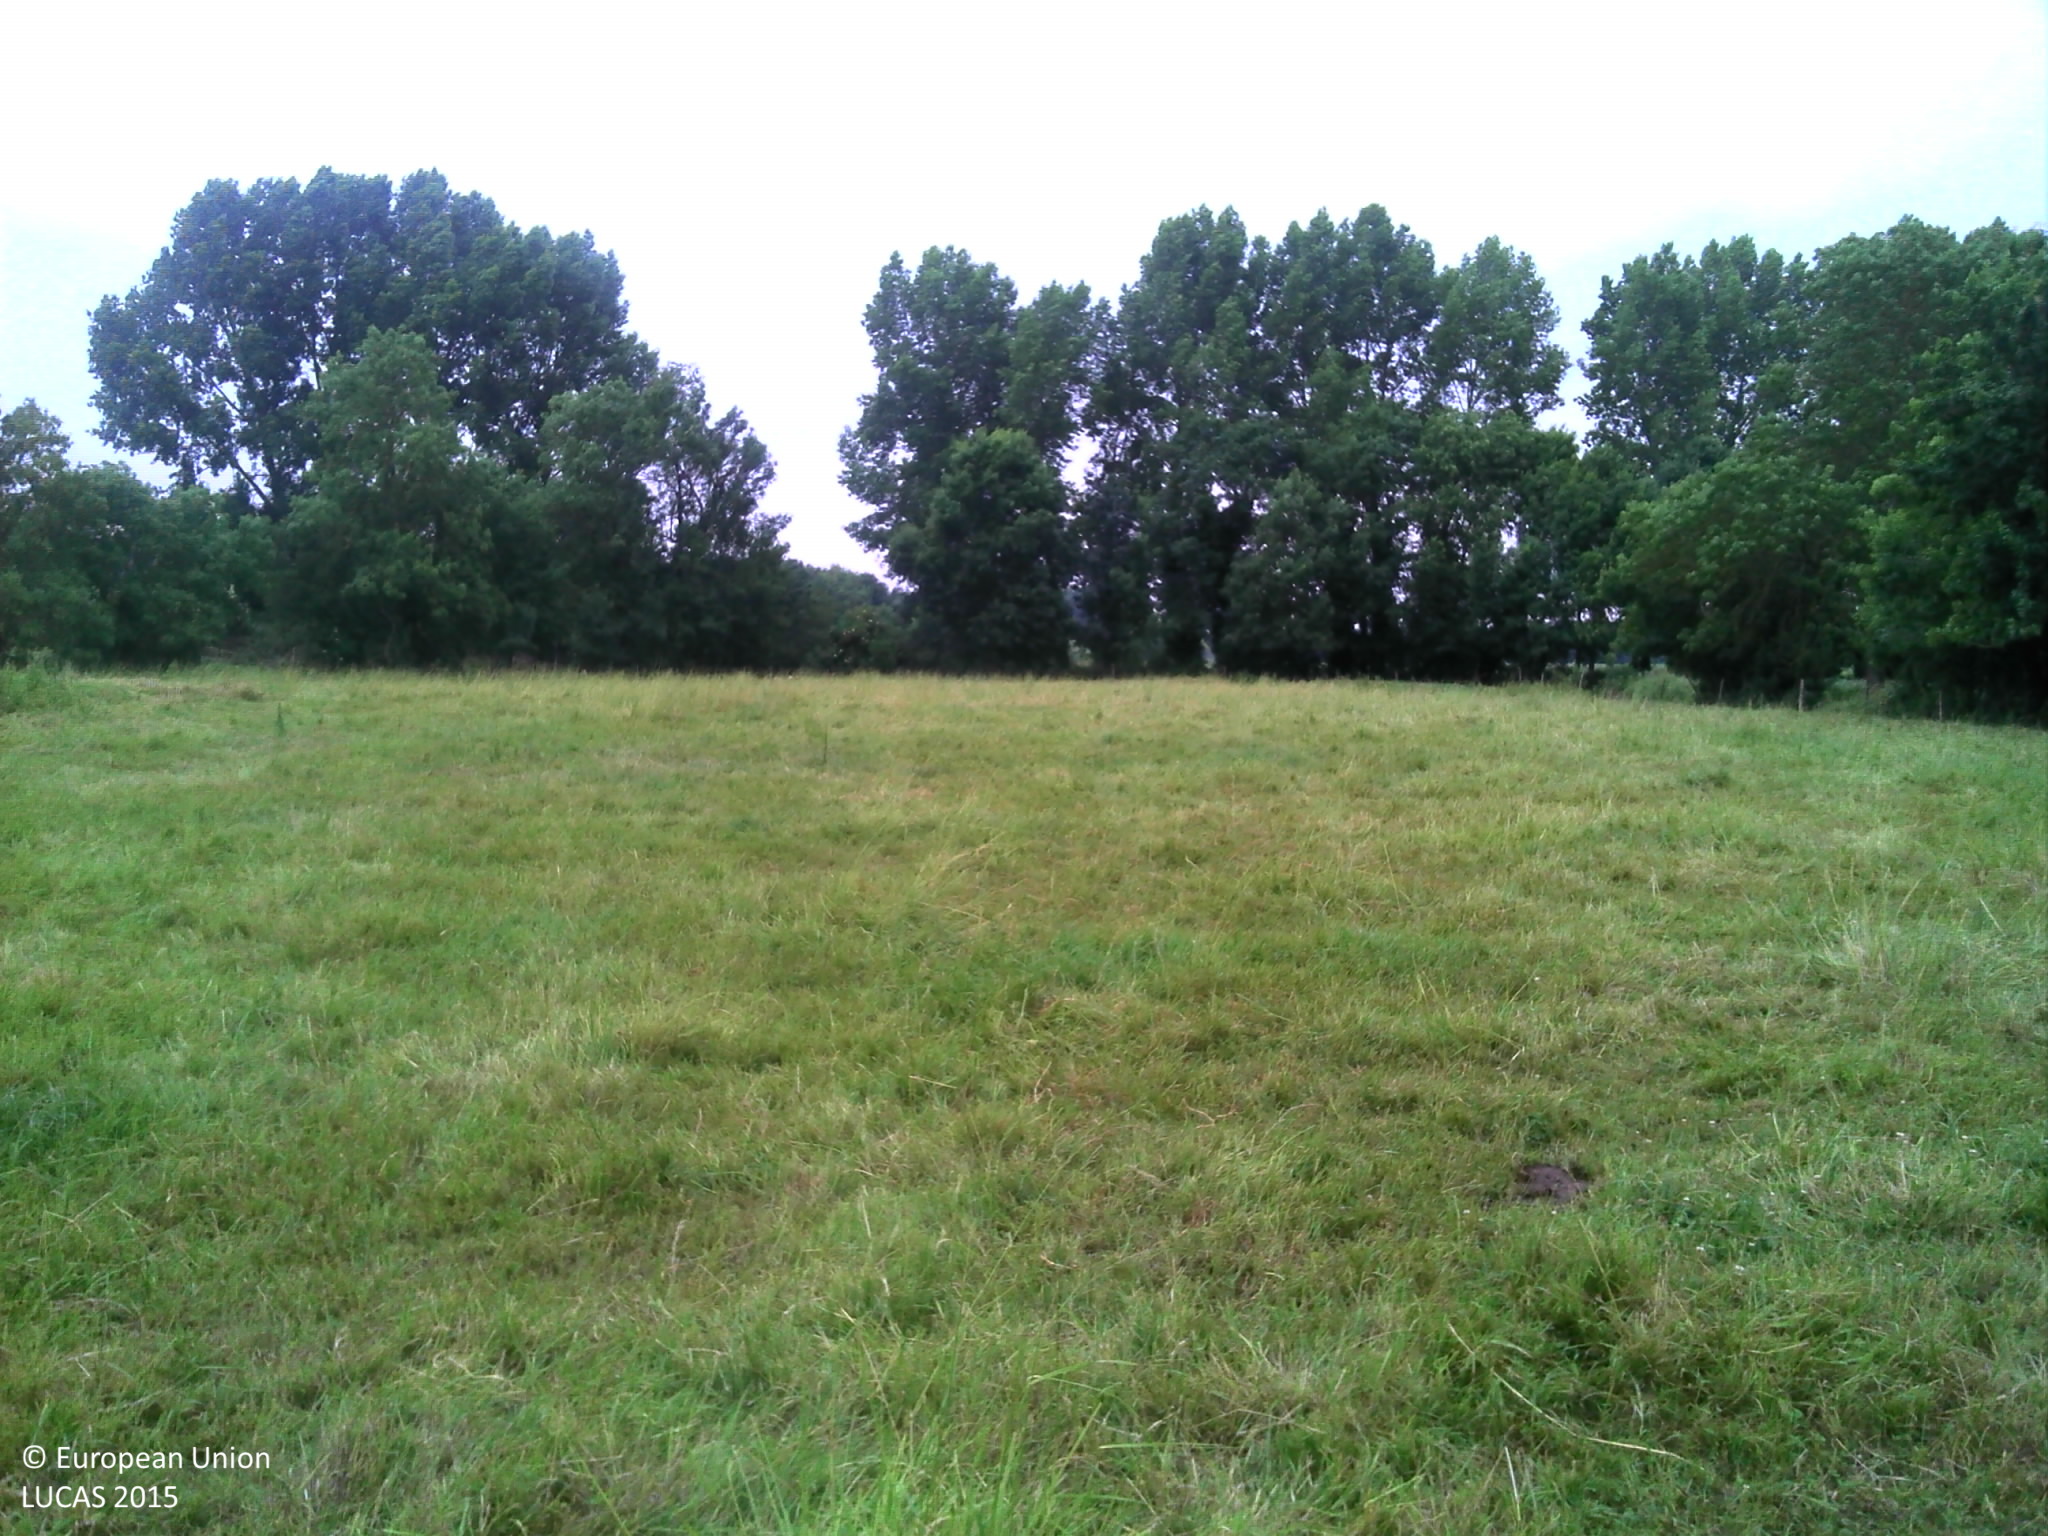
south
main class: Grassland
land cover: Grassland with sparse tree/shrub cover
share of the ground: > 75 %
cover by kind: herbaceous plants 95 %, broadleaved forest trees 5 %
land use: Agriculture (excluding fallow land and kitchen gardens)
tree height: > 5 m
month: June
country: FR
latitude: 45.8817
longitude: -0.9156
